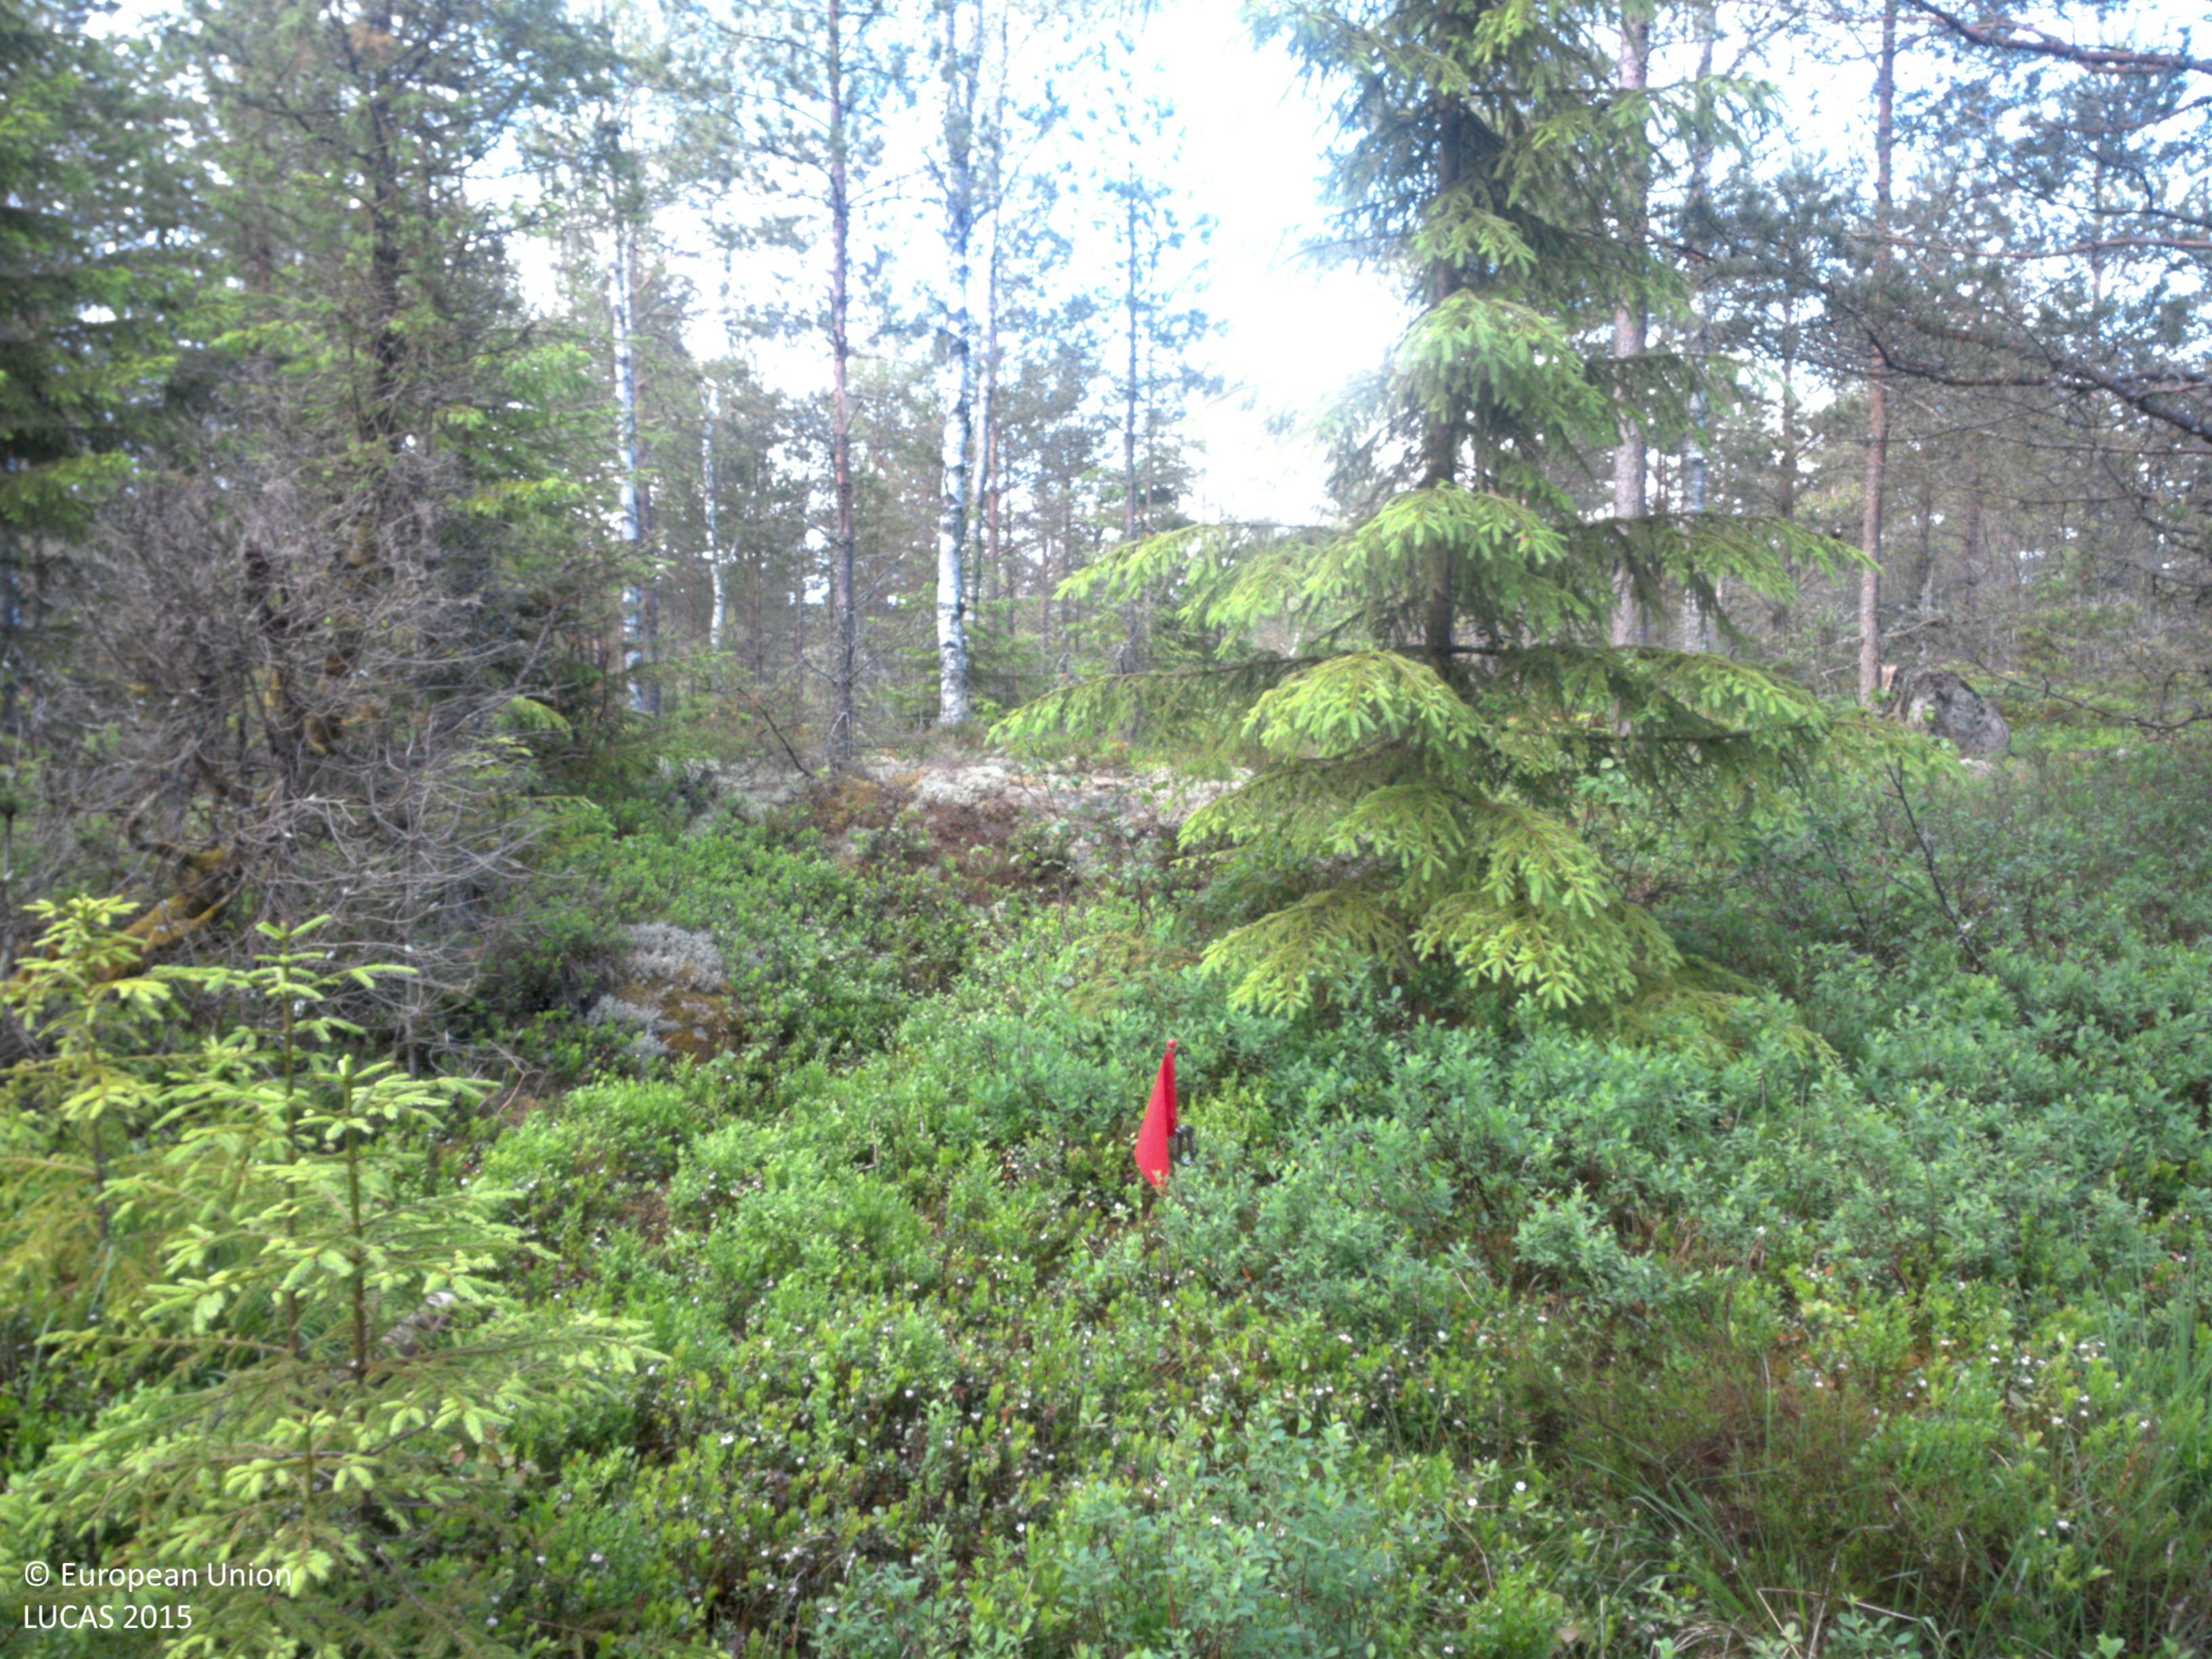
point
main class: Woodland
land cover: Other mixed woodland
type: boreal forest
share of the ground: 50 - 75 %
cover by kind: coniferous forest trees 50 %, herbaceous plants 30 %, broadleaved forest trees 20 %
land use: Forestry
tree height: > 5 m
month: June
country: SE
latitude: 58.8575
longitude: 11.6085
